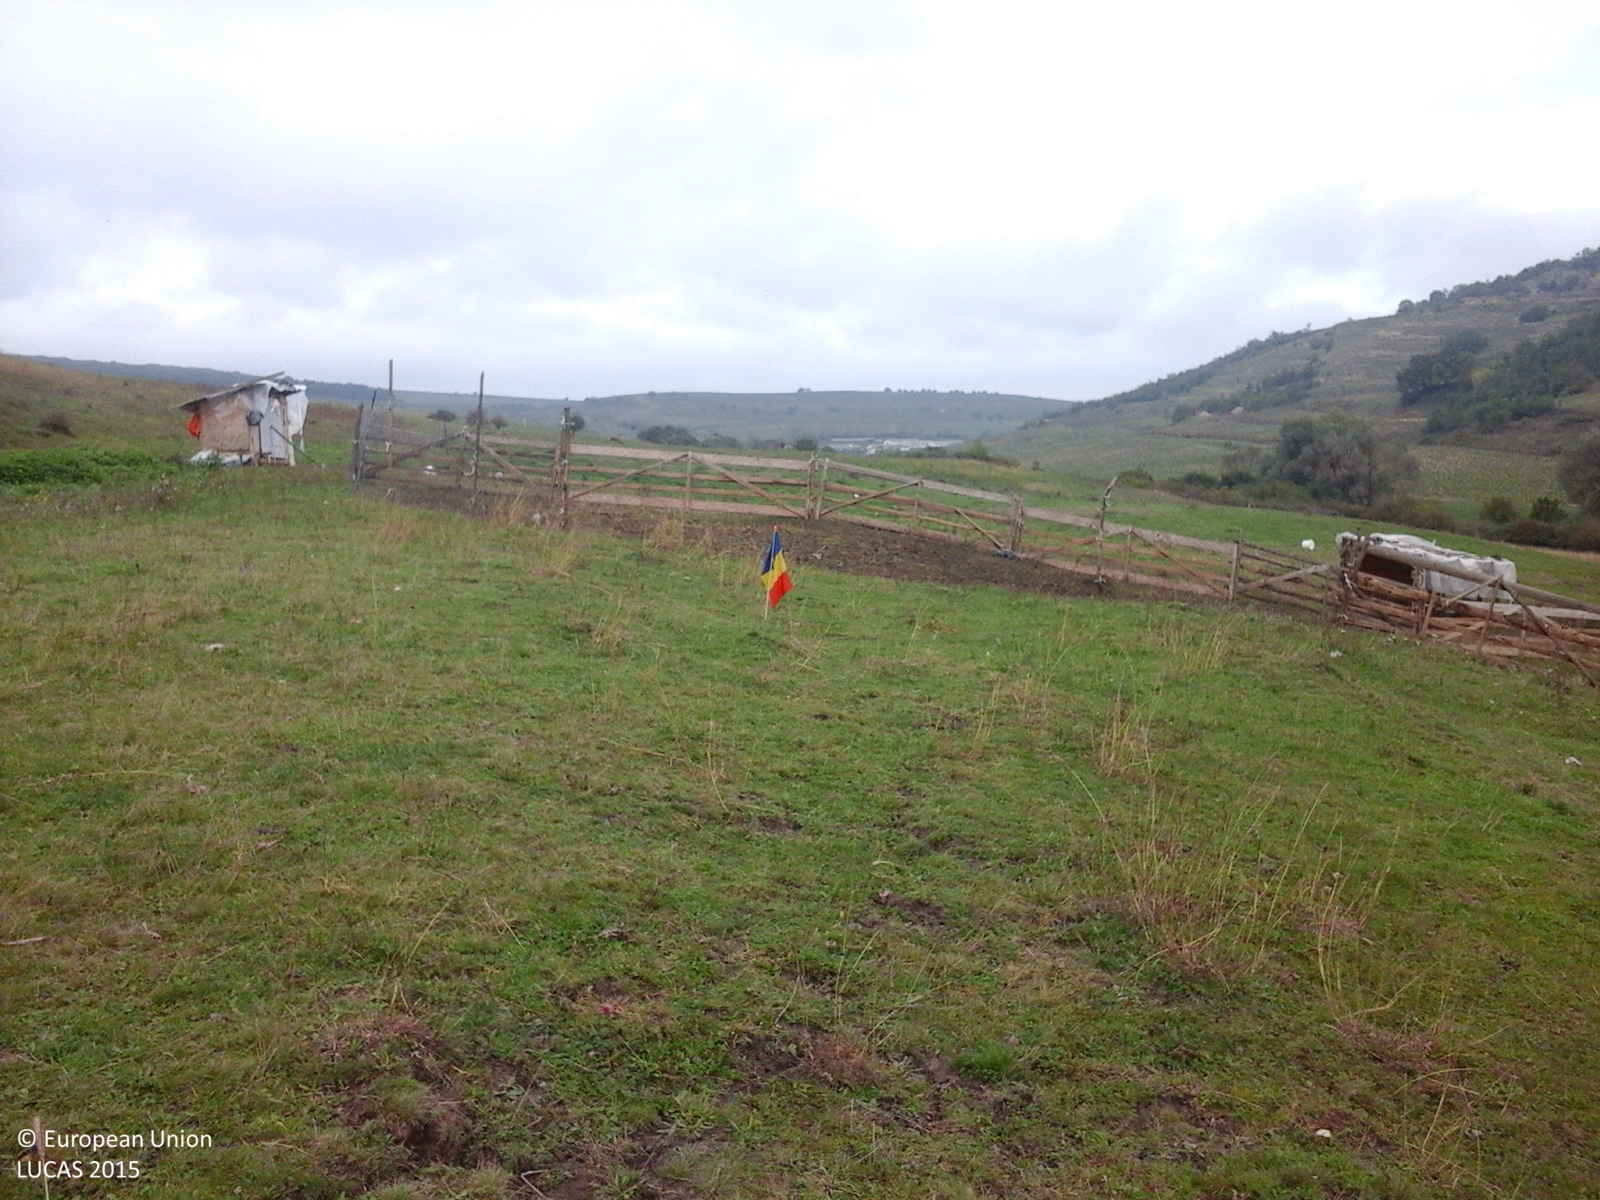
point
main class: Grassland
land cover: Grassland without tree/shrub cover
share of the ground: > 75 %
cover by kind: herbaceous plants 100 %
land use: Agriculture (excluding fallow land and kitchen gardens)
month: October
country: RO
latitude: 46.1958
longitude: 24.1107
